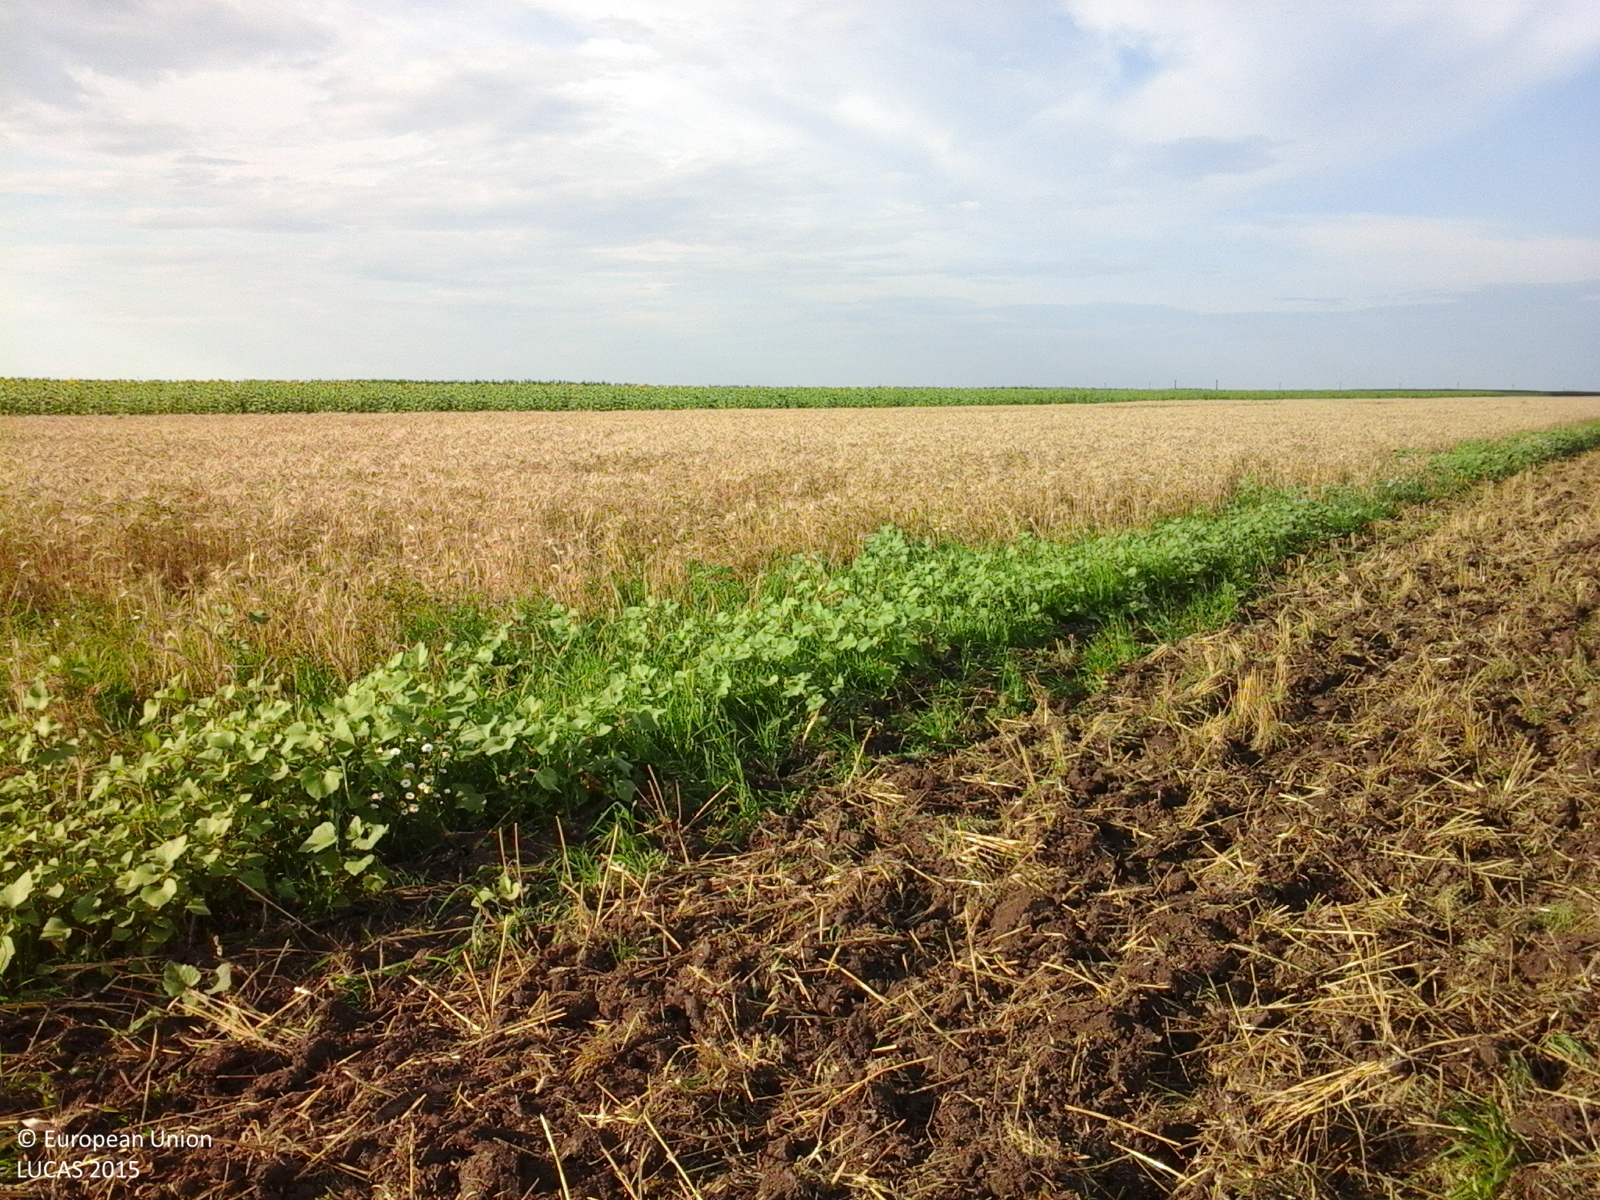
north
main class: Cropland
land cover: Common wheat
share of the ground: < 10 %
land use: Agriculture (excluding fallow land and kitchen gardens)
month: July
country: RO
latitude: 44.1803
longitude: 25.5379
